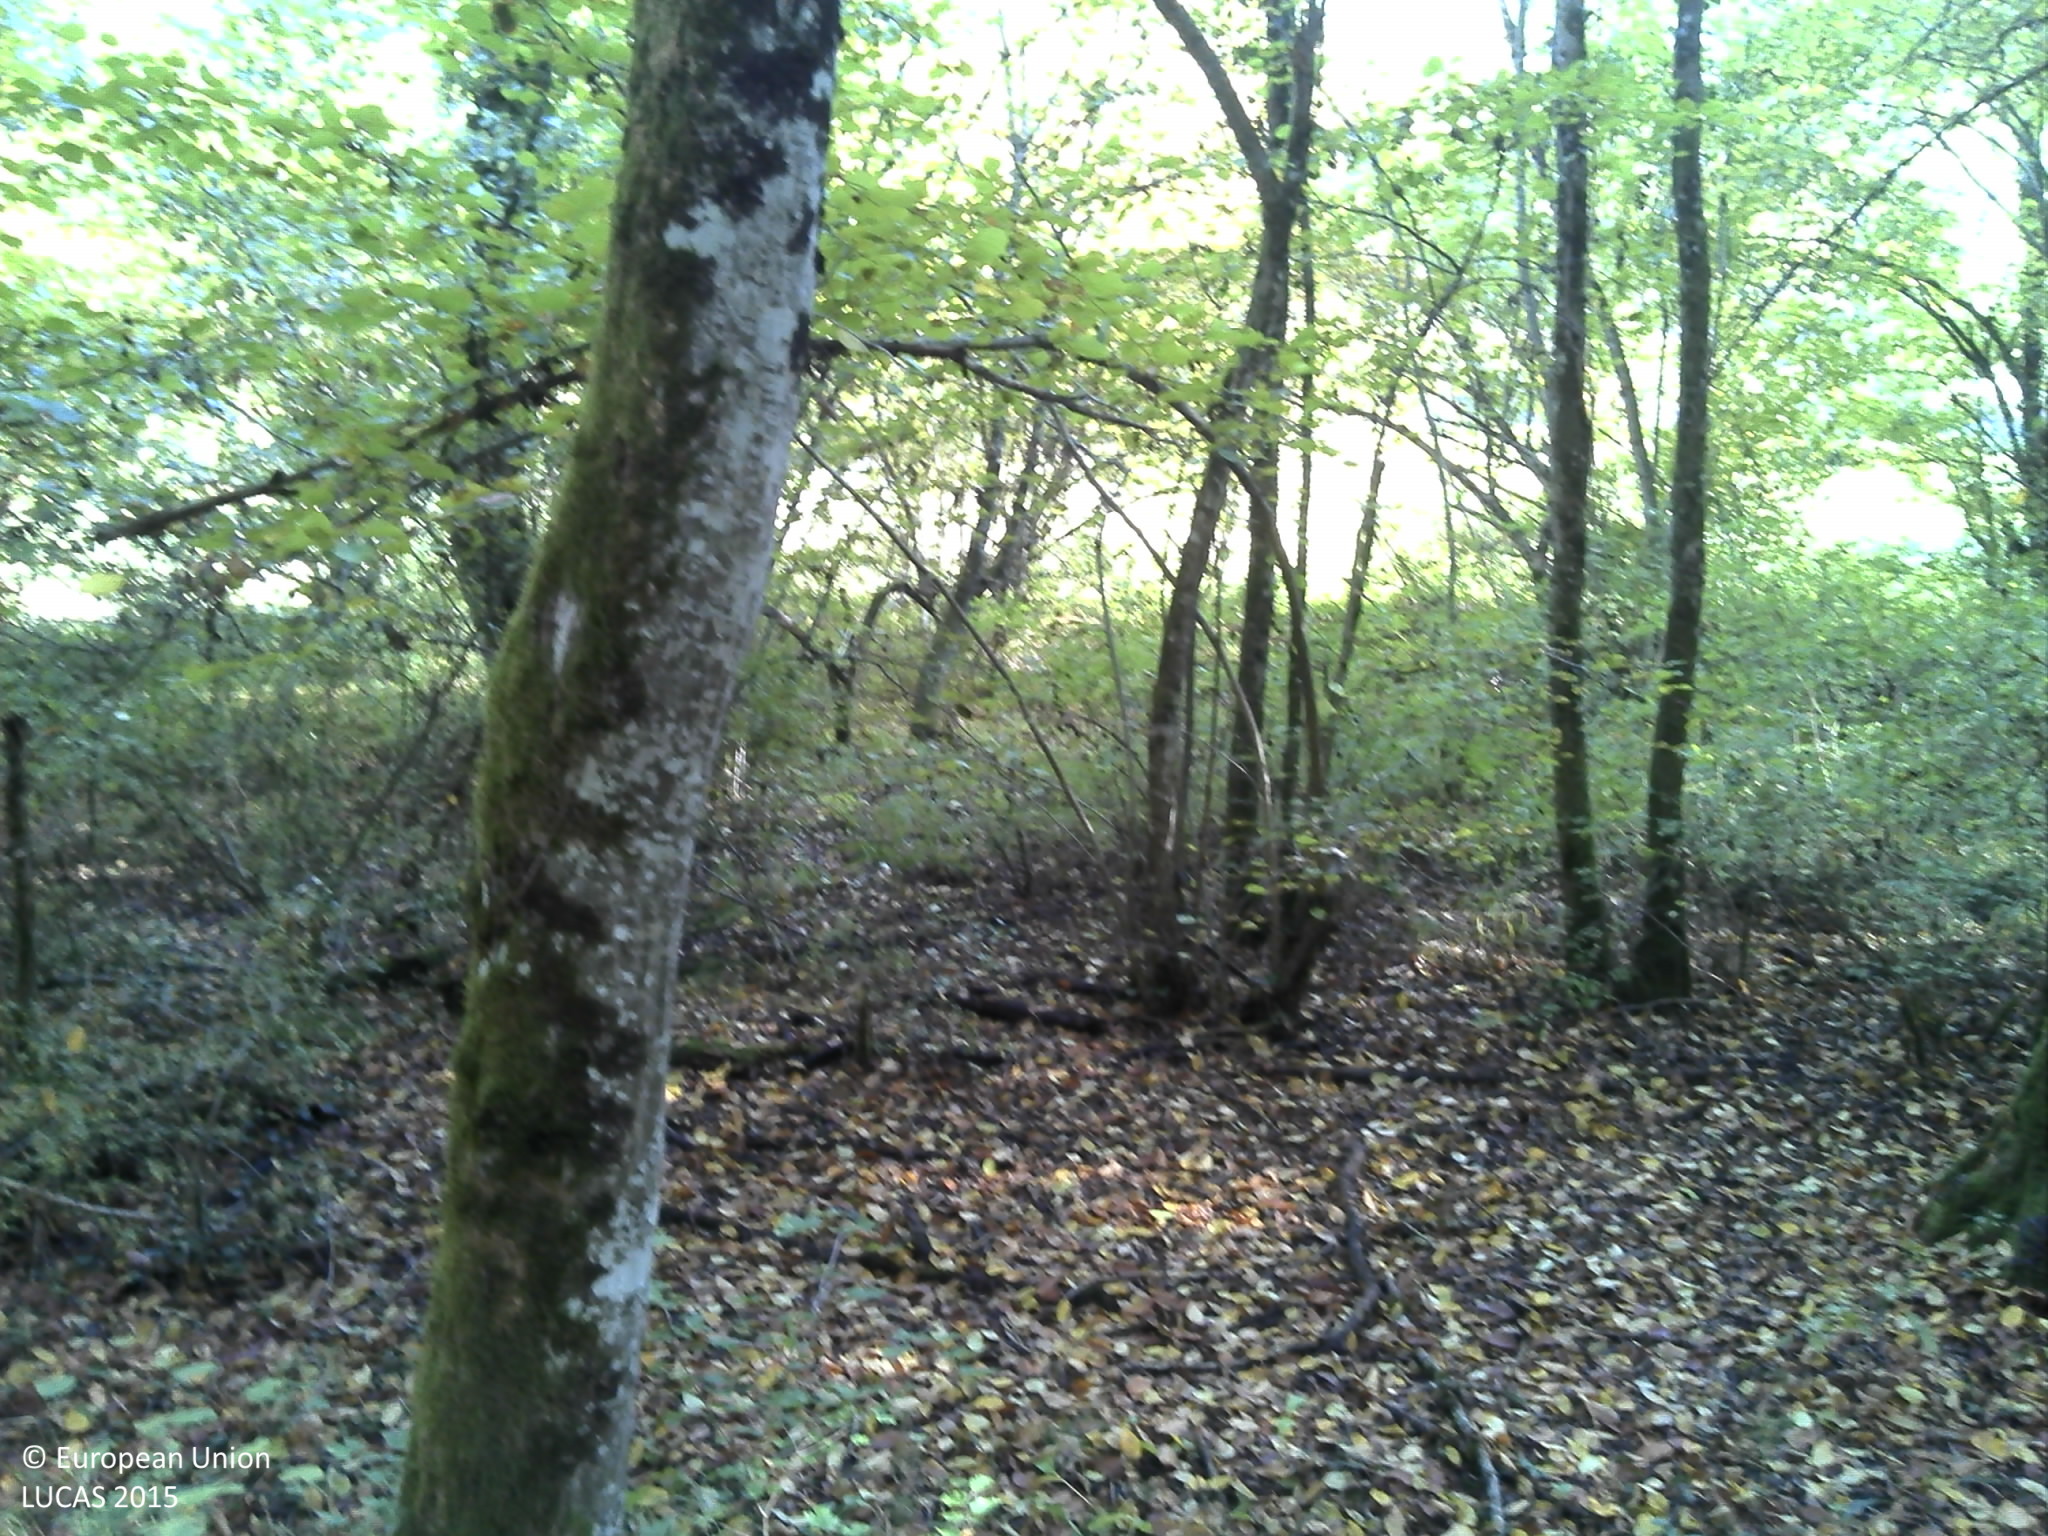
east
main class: Woodland
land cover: Broadleaved woodland
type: mesophytic deciduous forest
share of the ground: > 75 %
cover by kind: broadleaved forest trees 90 %, lichens and mosses 5 %, unconsolidated bare surface 5 %
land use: Forestry
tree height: > 5 m
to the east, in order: Broadleaved woodland; Rivers and streams; Broadleaved woodland; Grassland without tree/shrub cover; Broadleaved woodland; Rivers and streams; Broadleaved woodland; Grassland without tree/shrub cover; Broadleaved woodland; Grassland without tree/shrub cover; Fences; Grassland without tree/shrub cover; Broadleaved woodland
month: October
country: FR
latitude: 45.8916
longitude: 5.4030
